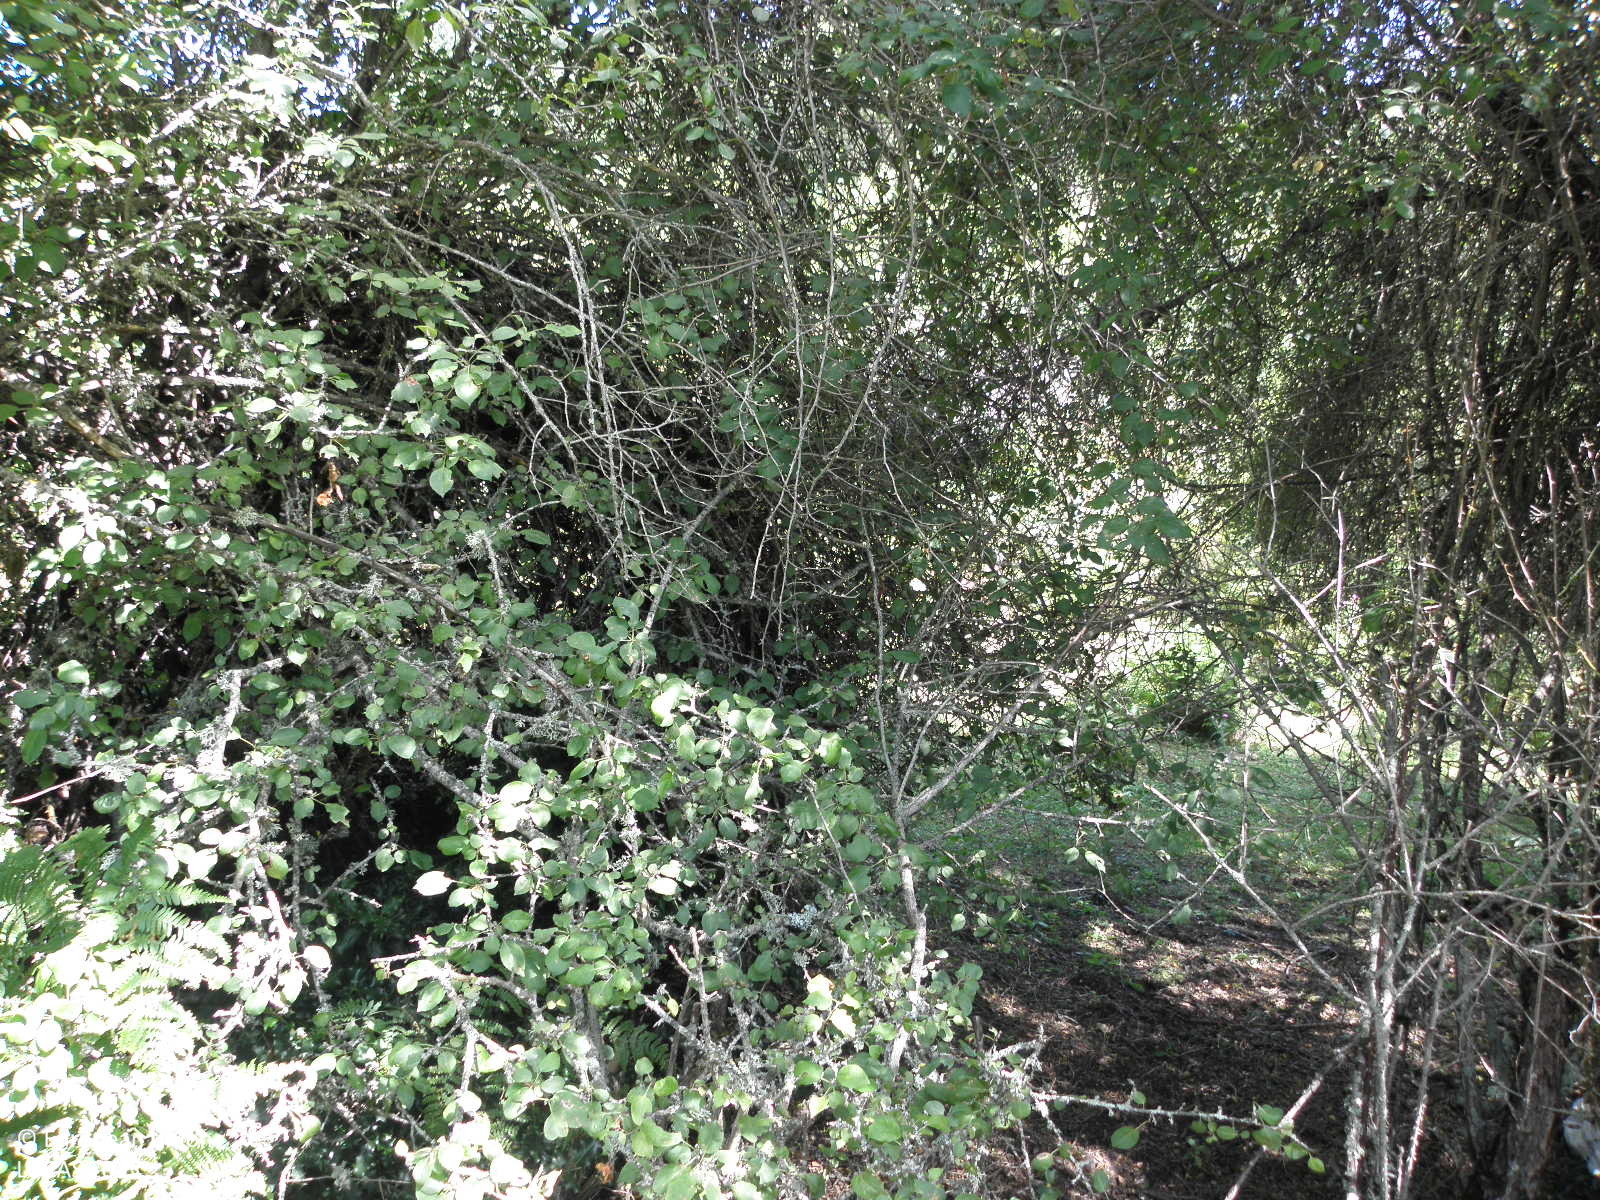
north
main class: Woodland
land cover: Broadleaved woodland
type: thermophilous deciduous forest
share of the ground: 50 - 75 %
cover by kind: broadleaved forest trees 50 %, shrubs 25 %, herbaceous plants 20 %, coniferous forest trees 5 %
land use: Semi-natural and natural areas not in use
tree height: > 5 m
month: August
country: GR
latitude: 39.9184
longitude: 22.3825
